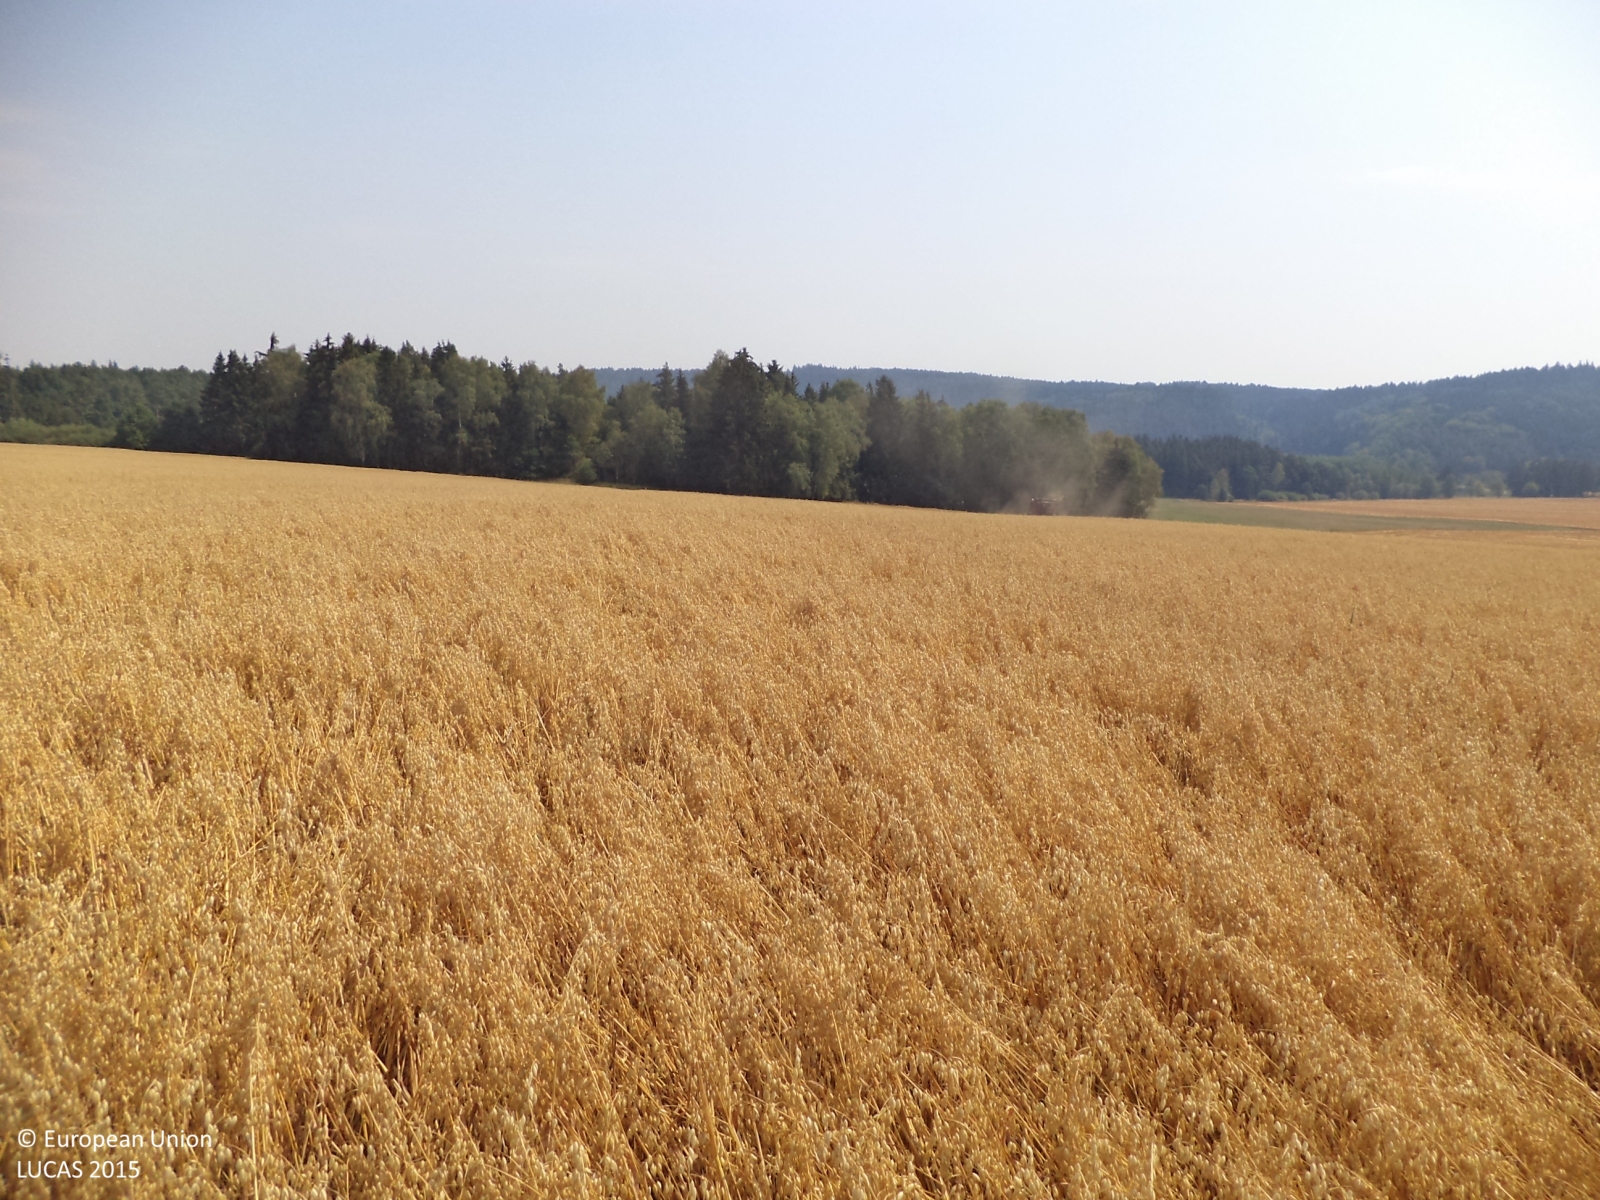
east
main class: Cropland
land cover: Oats
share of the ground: > 75 %
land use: Agriculture (excluding fallow land and kitchen gardens)
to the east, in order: Oats; Spruce dominated mixed woodland
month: August
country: CZ
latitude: 49.4319
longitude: 14.4275
